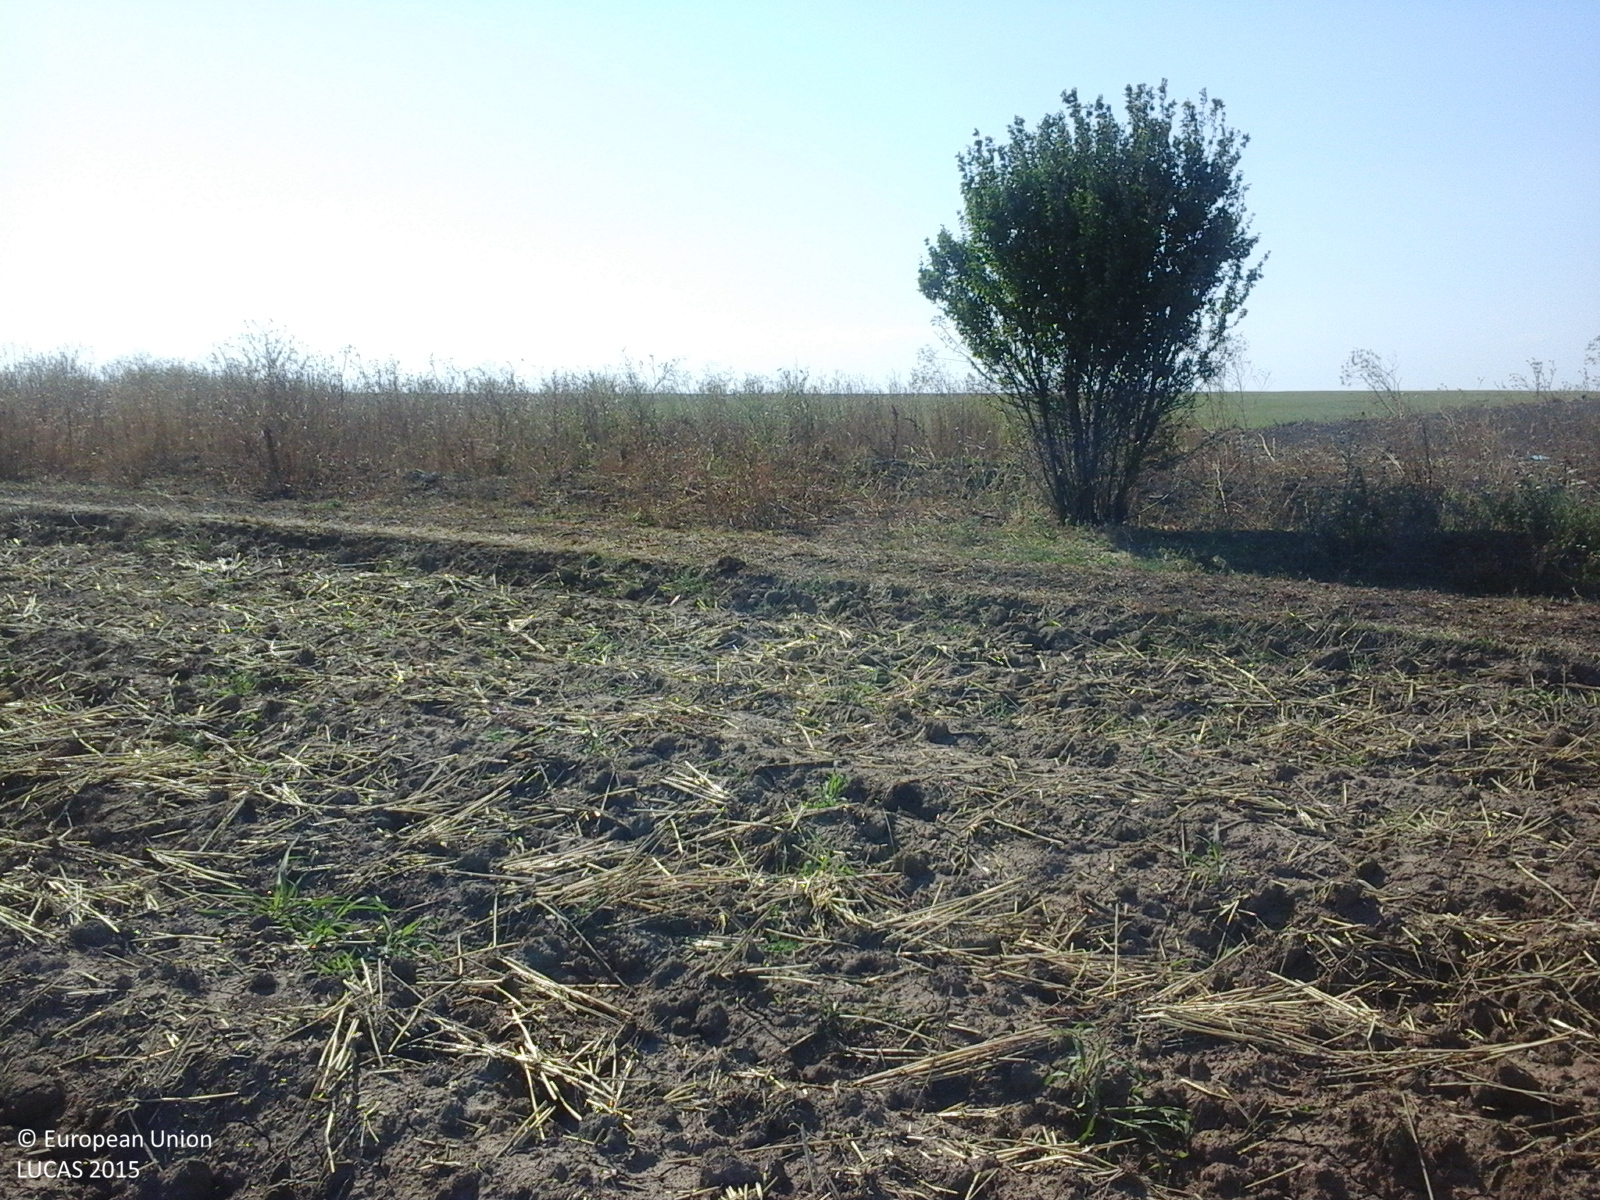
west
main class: Cropland
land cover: Common wheat
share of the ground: 25 - 50 %
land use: Agriculture (excluding fallow land and kitchen gardens)
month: August
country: RO
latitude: 44.2670
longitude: 28.4463
